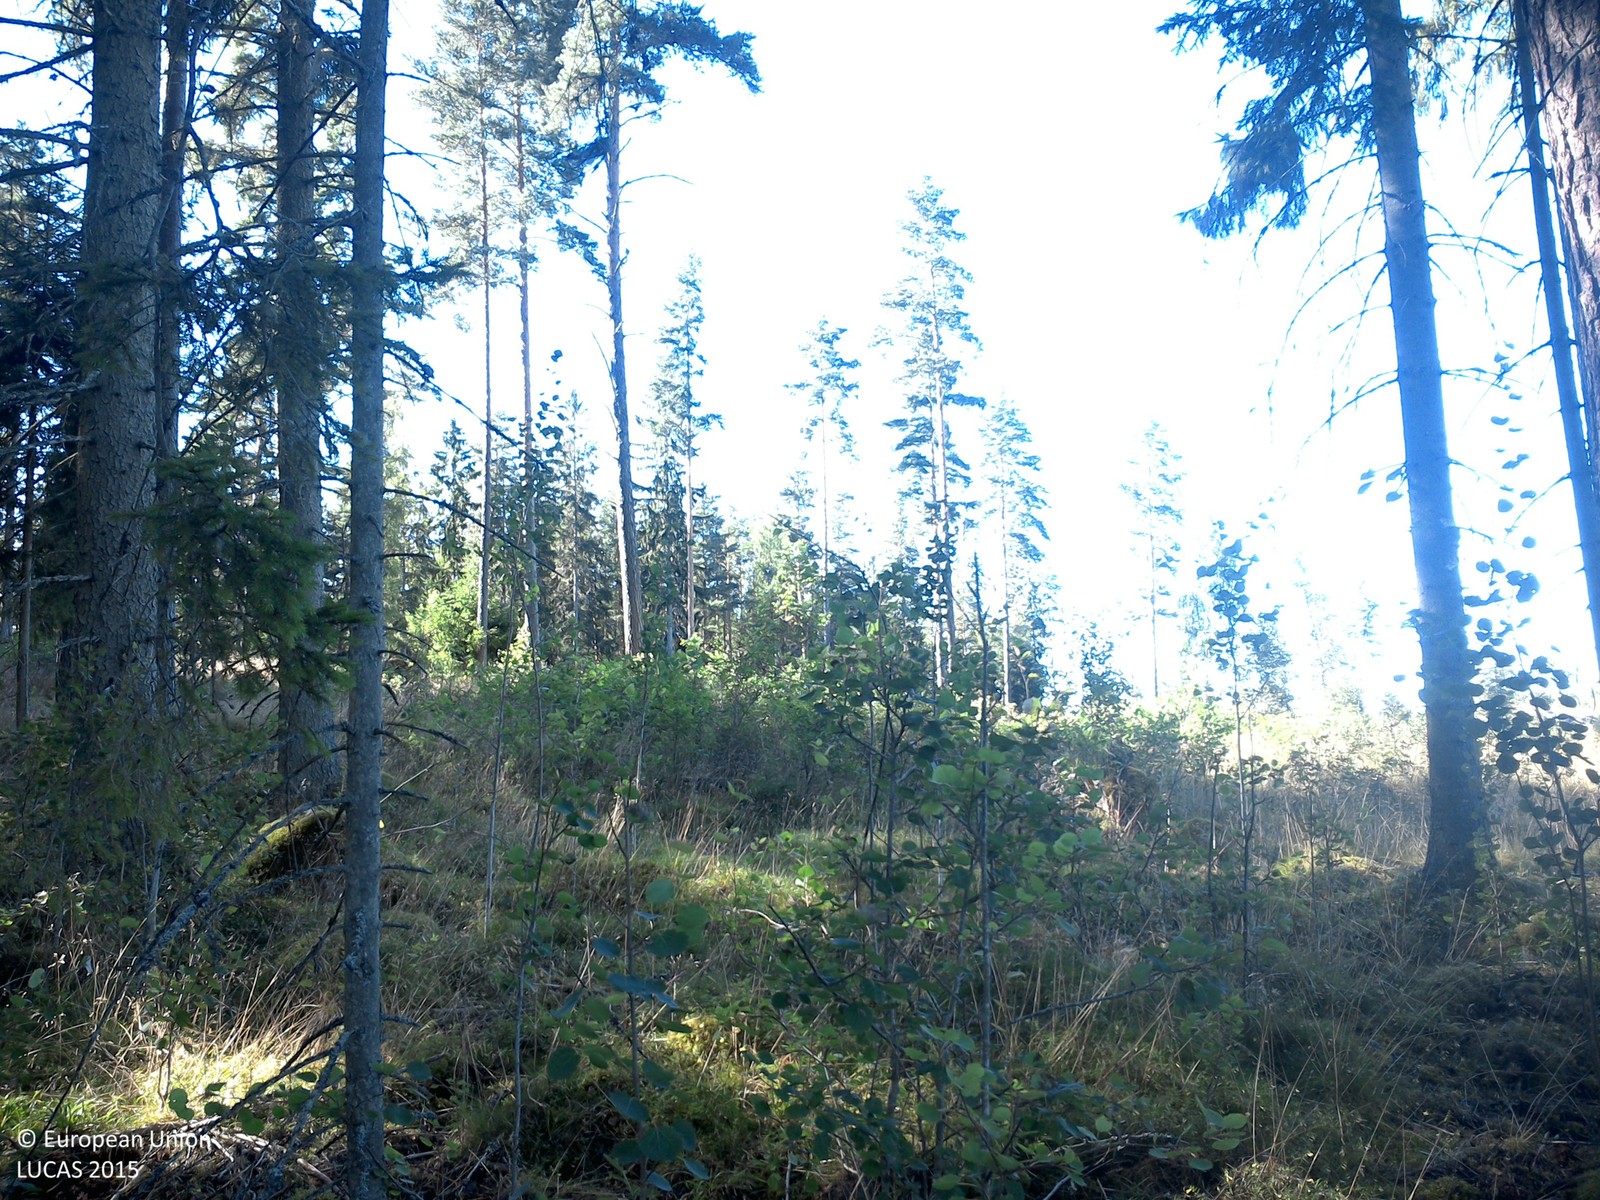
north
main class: Woodland
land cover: Spruce dominated coniferous woodland
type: boreal forest
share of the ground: 50 - 75 %
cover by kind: coniferous forest trees 55 %, lichens and mosses 45 %
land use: Forestry
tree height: > 5 m
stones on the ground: < 10 %
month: August
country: SE
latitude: 58.2236
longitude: 15.2896
